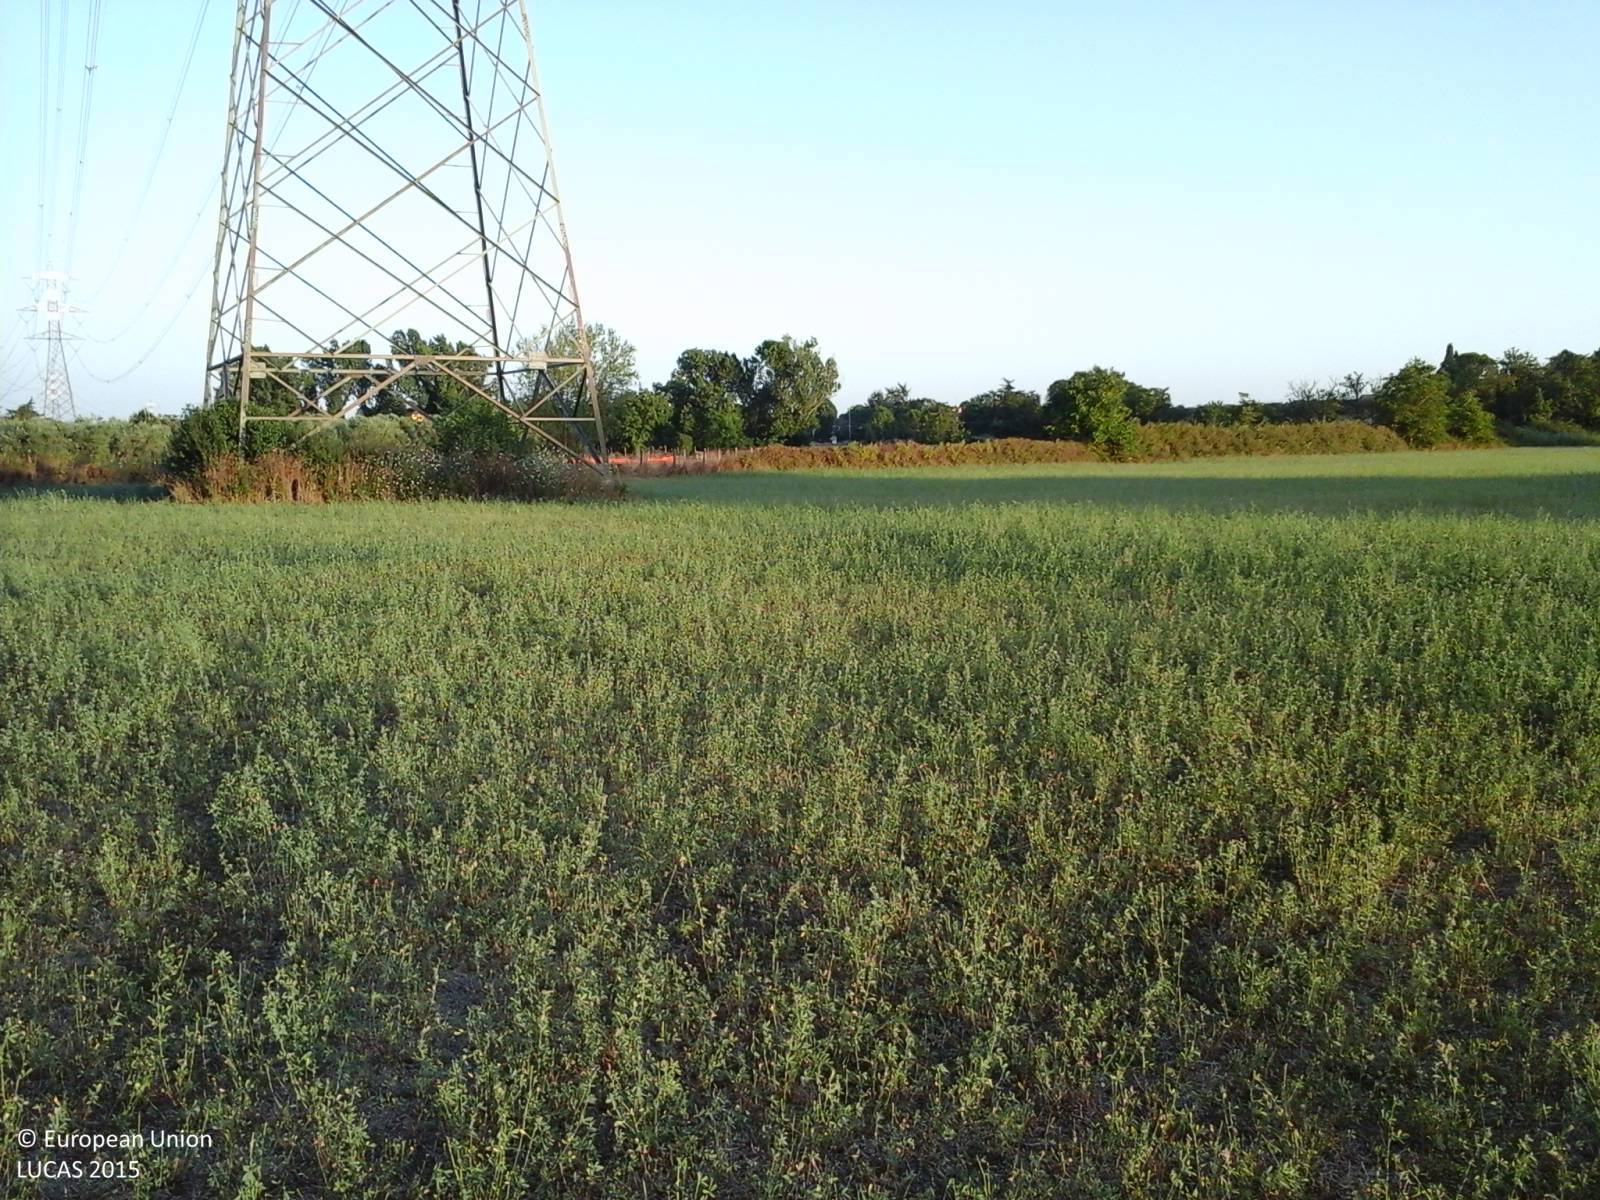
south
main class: Cropland
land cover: Lucerne
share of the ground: > 75 %
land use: Agriculture (excluding fallow land and kitchen gardens)
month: July
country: IT
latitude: 42.1335
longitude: 12.5678
